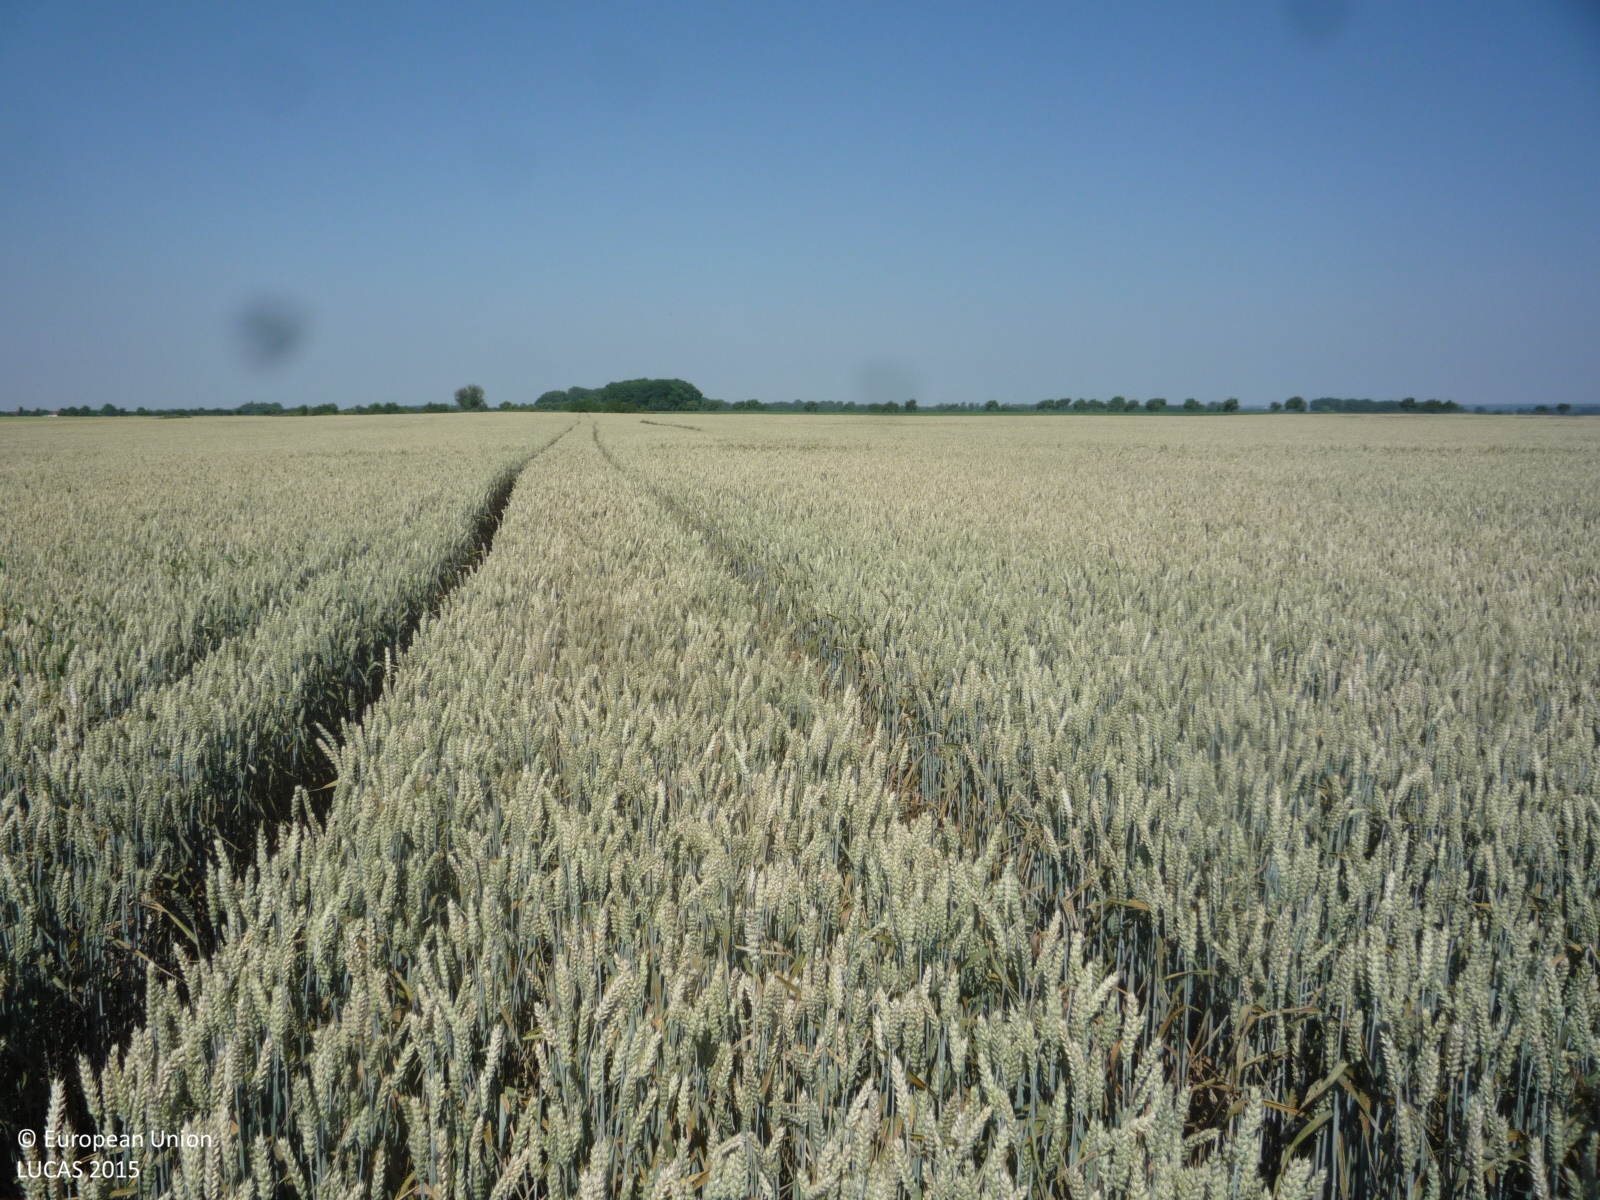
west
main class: Cropland
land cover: Common wheat
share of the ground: > 75 %
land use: Agriculture (excluding fallow land and kitchen gardens)
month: July
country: CZ
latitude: 50.2097
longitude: 15.2019
